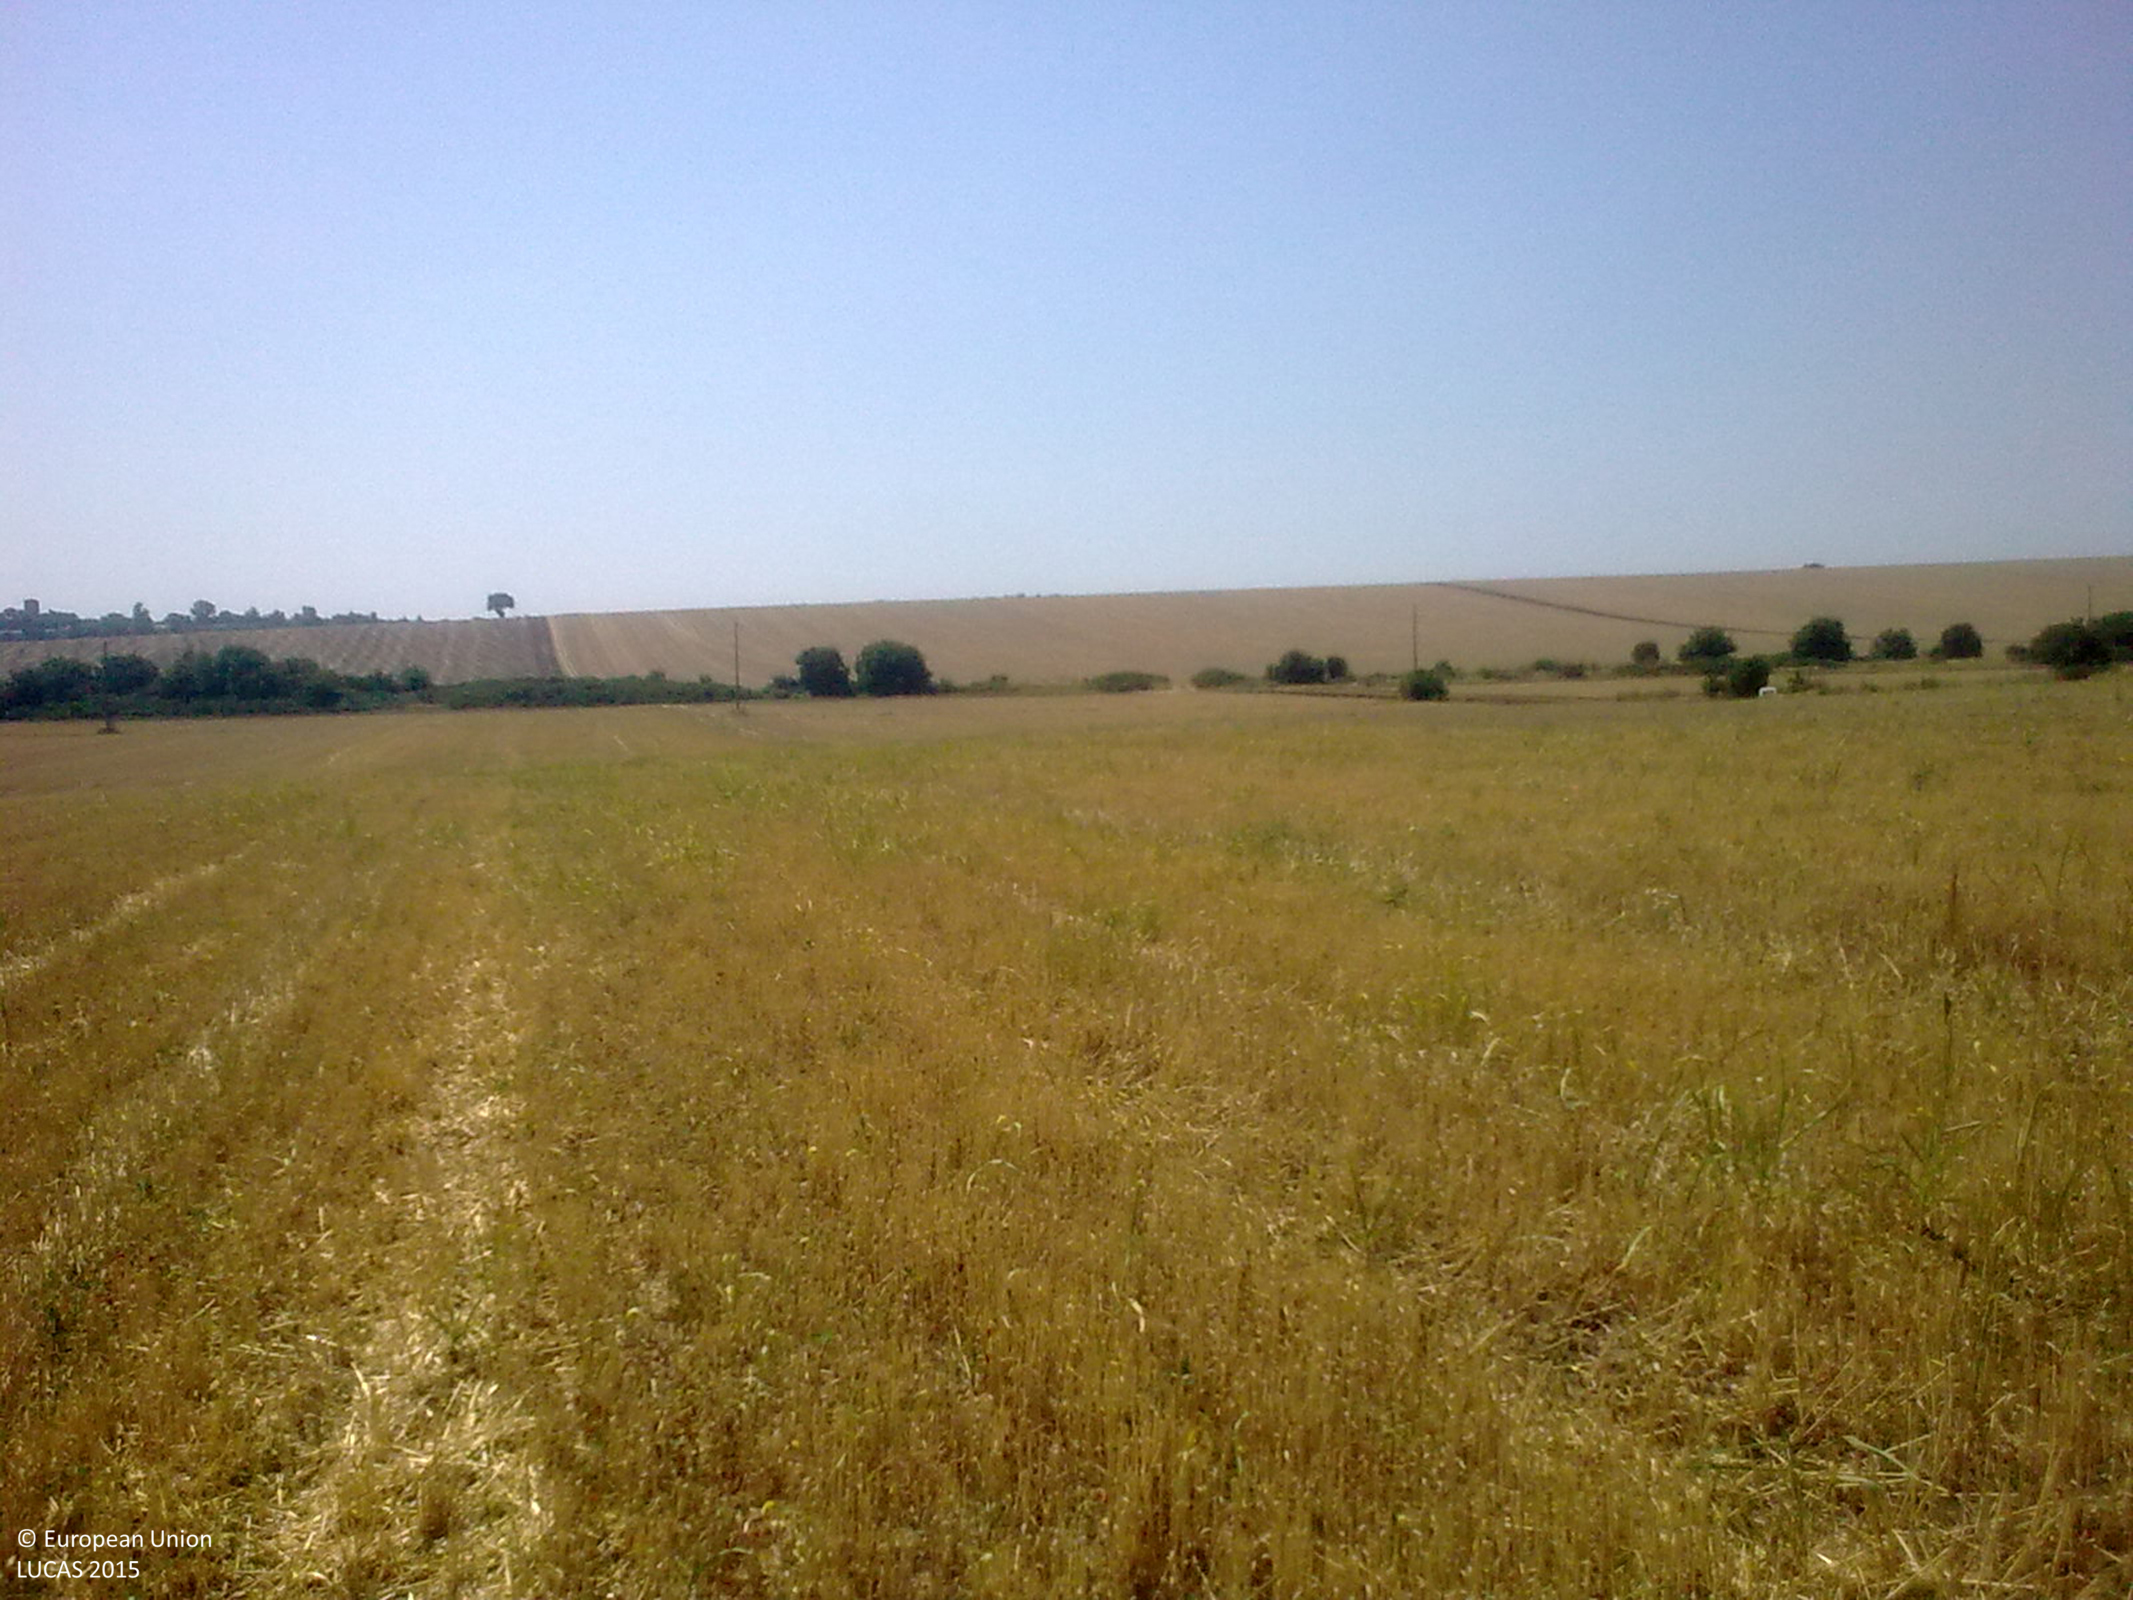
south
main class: Cropland
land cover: Common wheat
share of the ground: > 75 %
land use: Agriculture (excluding fallow land and kitchen gardens)
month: July
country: BG
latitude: 43.8844
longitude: 26.1442
